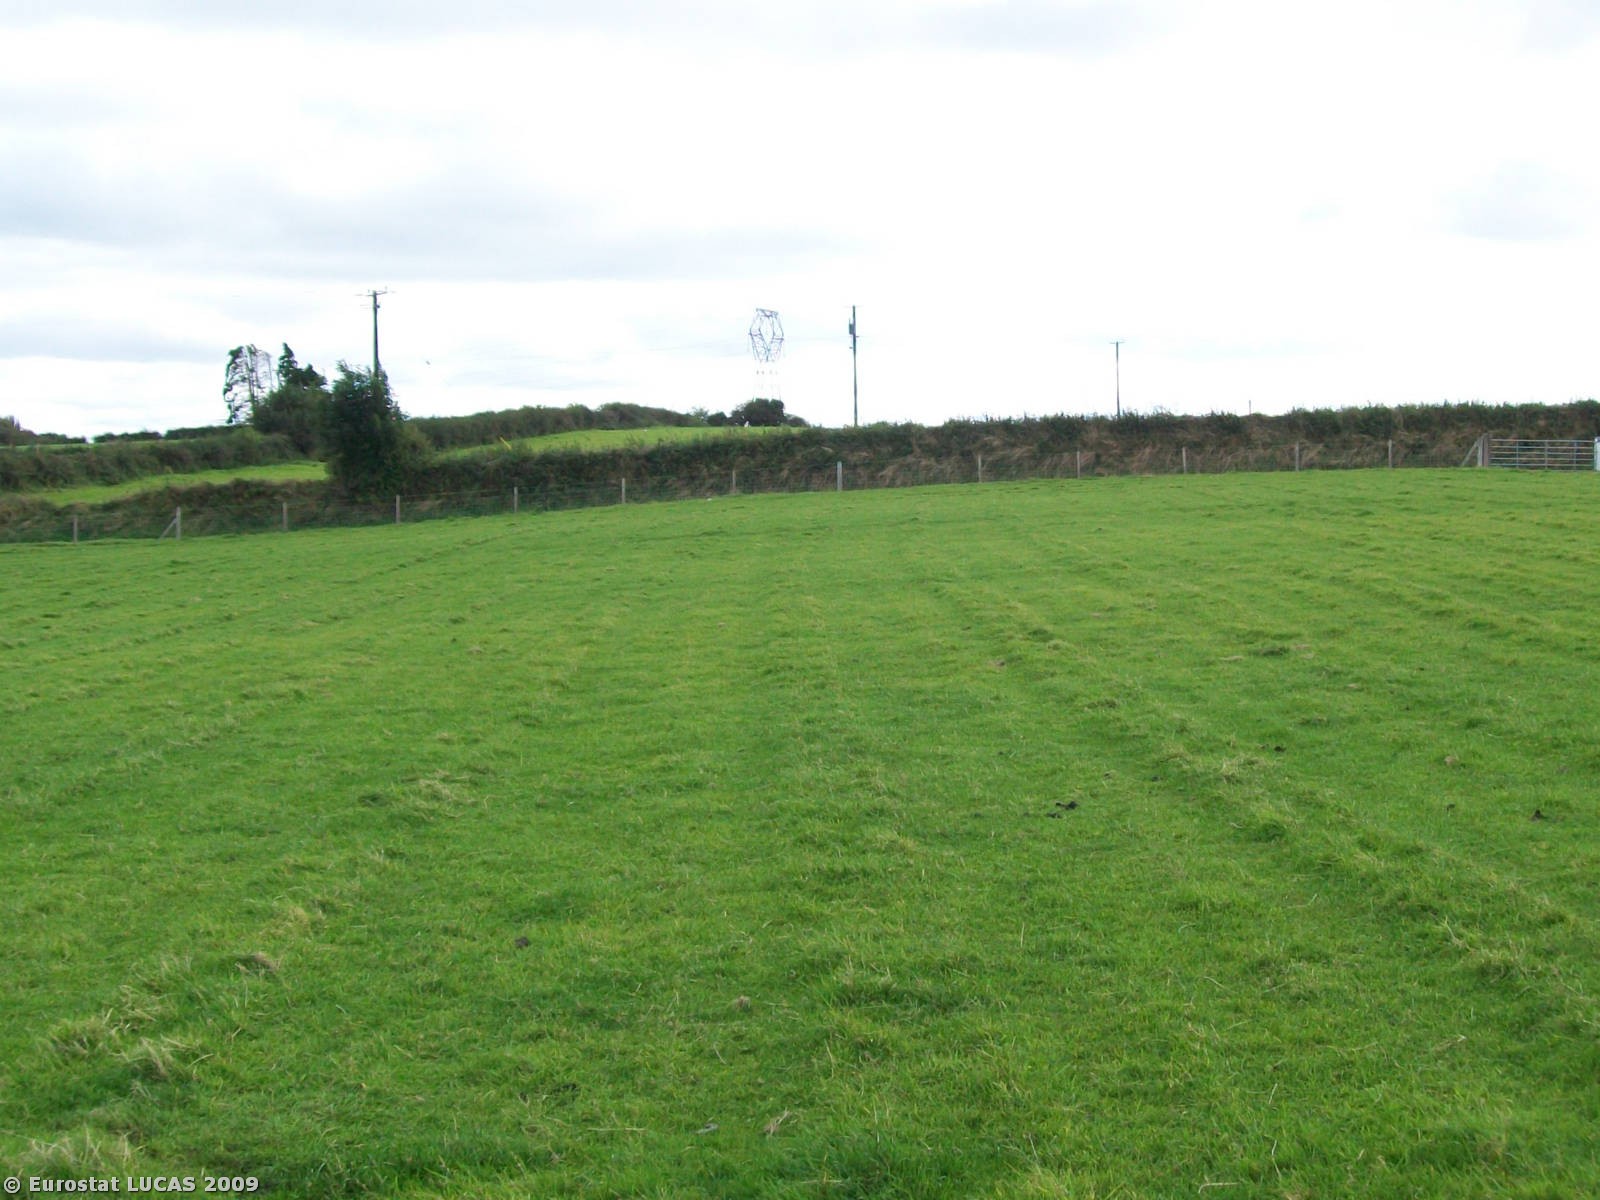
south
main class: Grassland
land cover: Grassland without tree/shrub cover
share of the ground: > 75 %
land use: Agriculture (excluding fallow land and kitchen gardens)
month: September
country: IE
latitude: 53.1793
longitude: -8.3684
